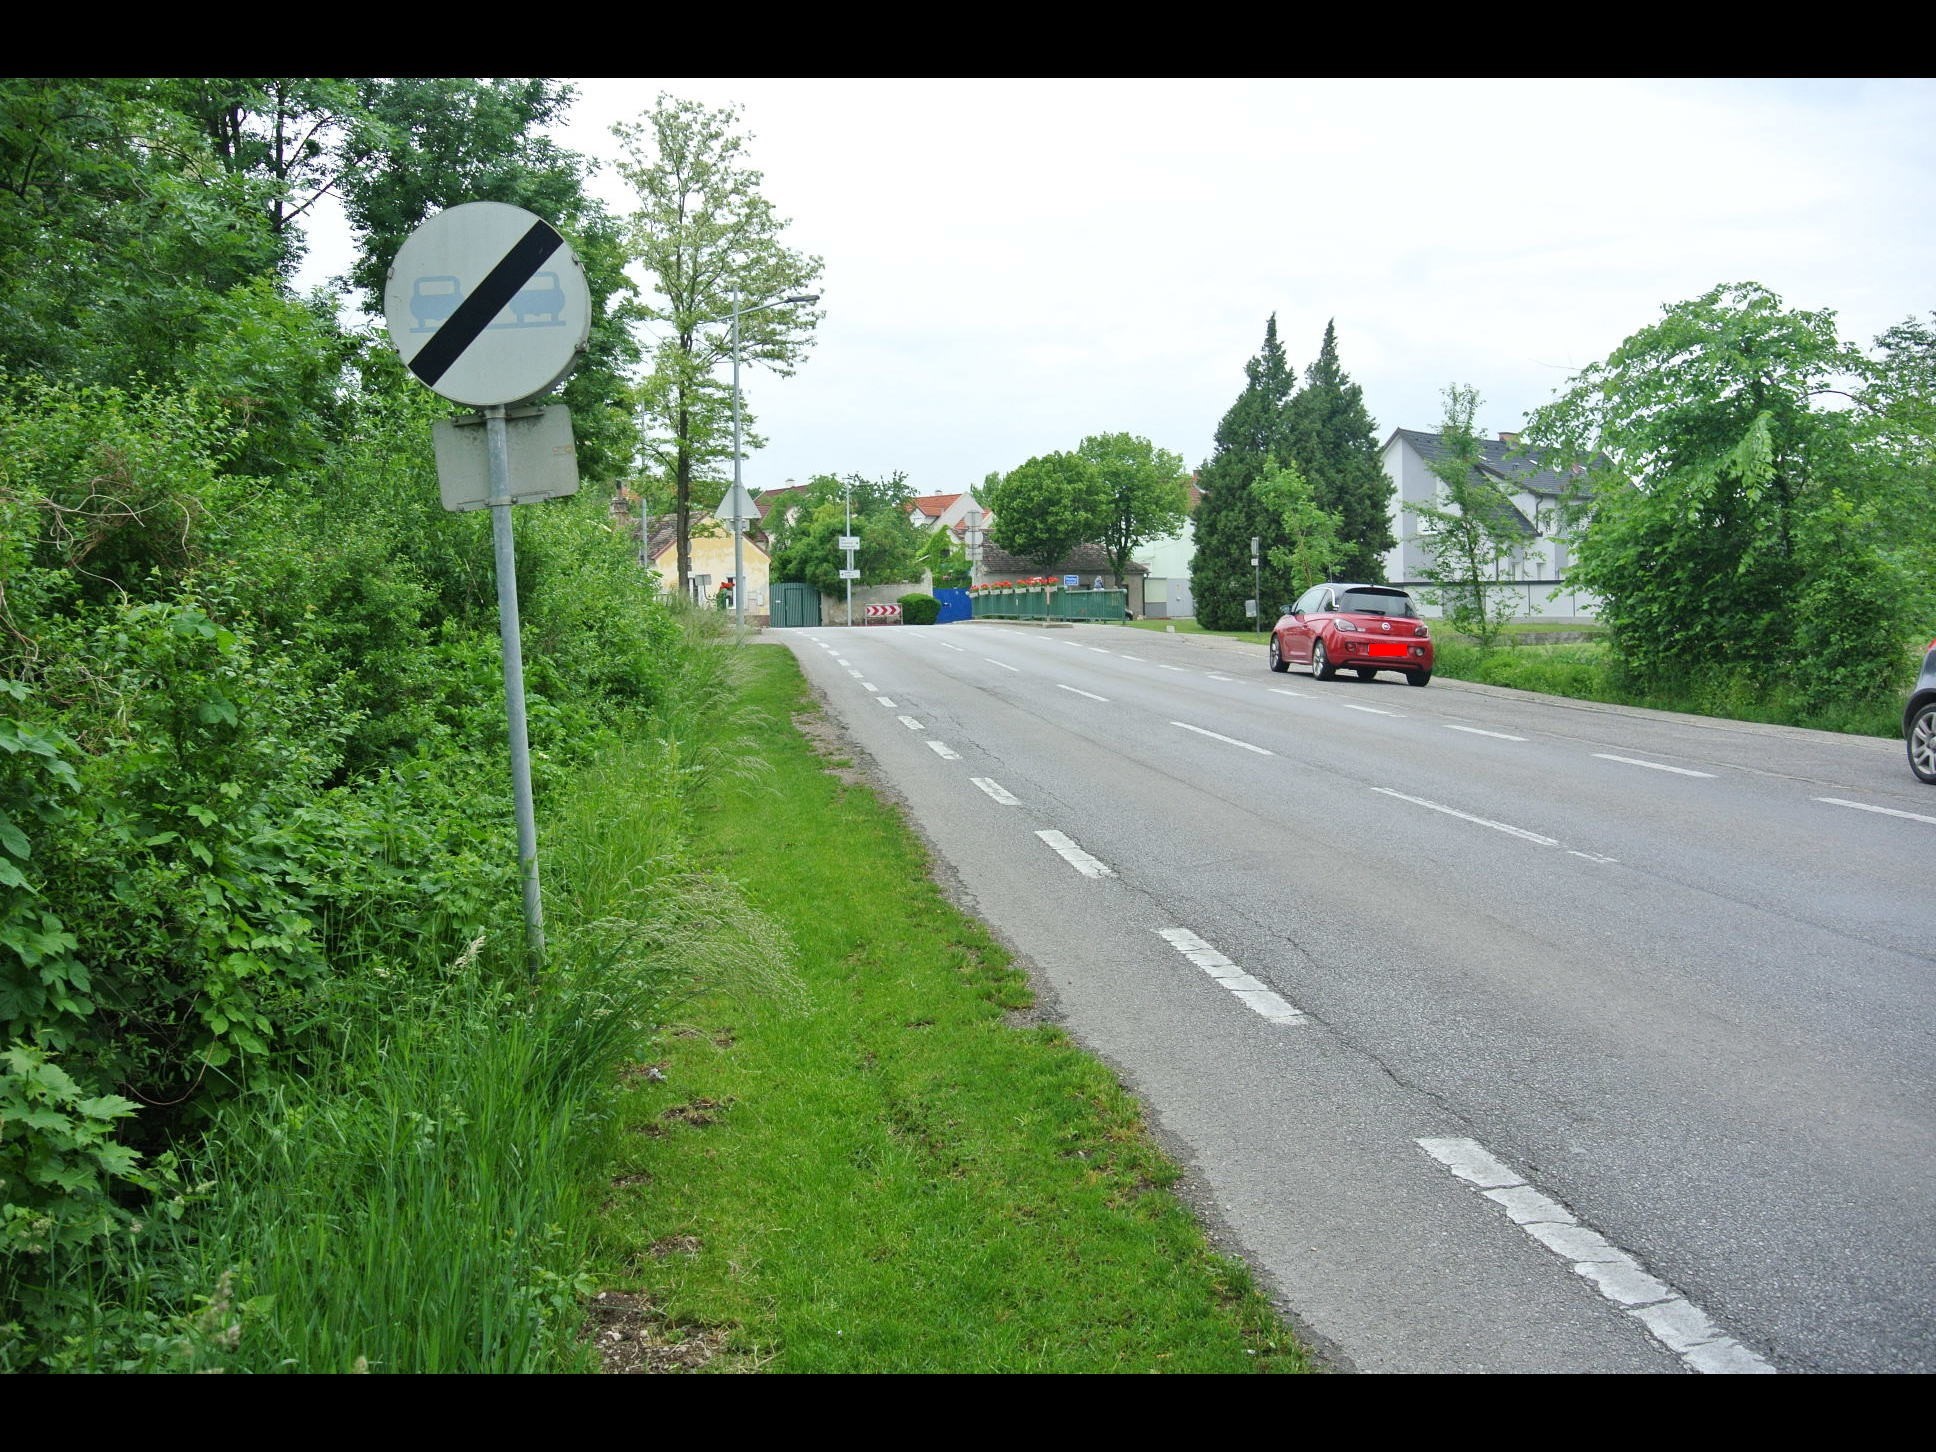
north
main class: Woodland
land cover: Broadleaved woodland
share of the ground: > 75 %
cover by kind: broadleaved forest trees 85 %, shrubs 15 %
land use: Semi-natural and natural areas not in use
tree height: > 5 m
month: May
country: AT
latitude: 48.0164
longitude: 16.4536
